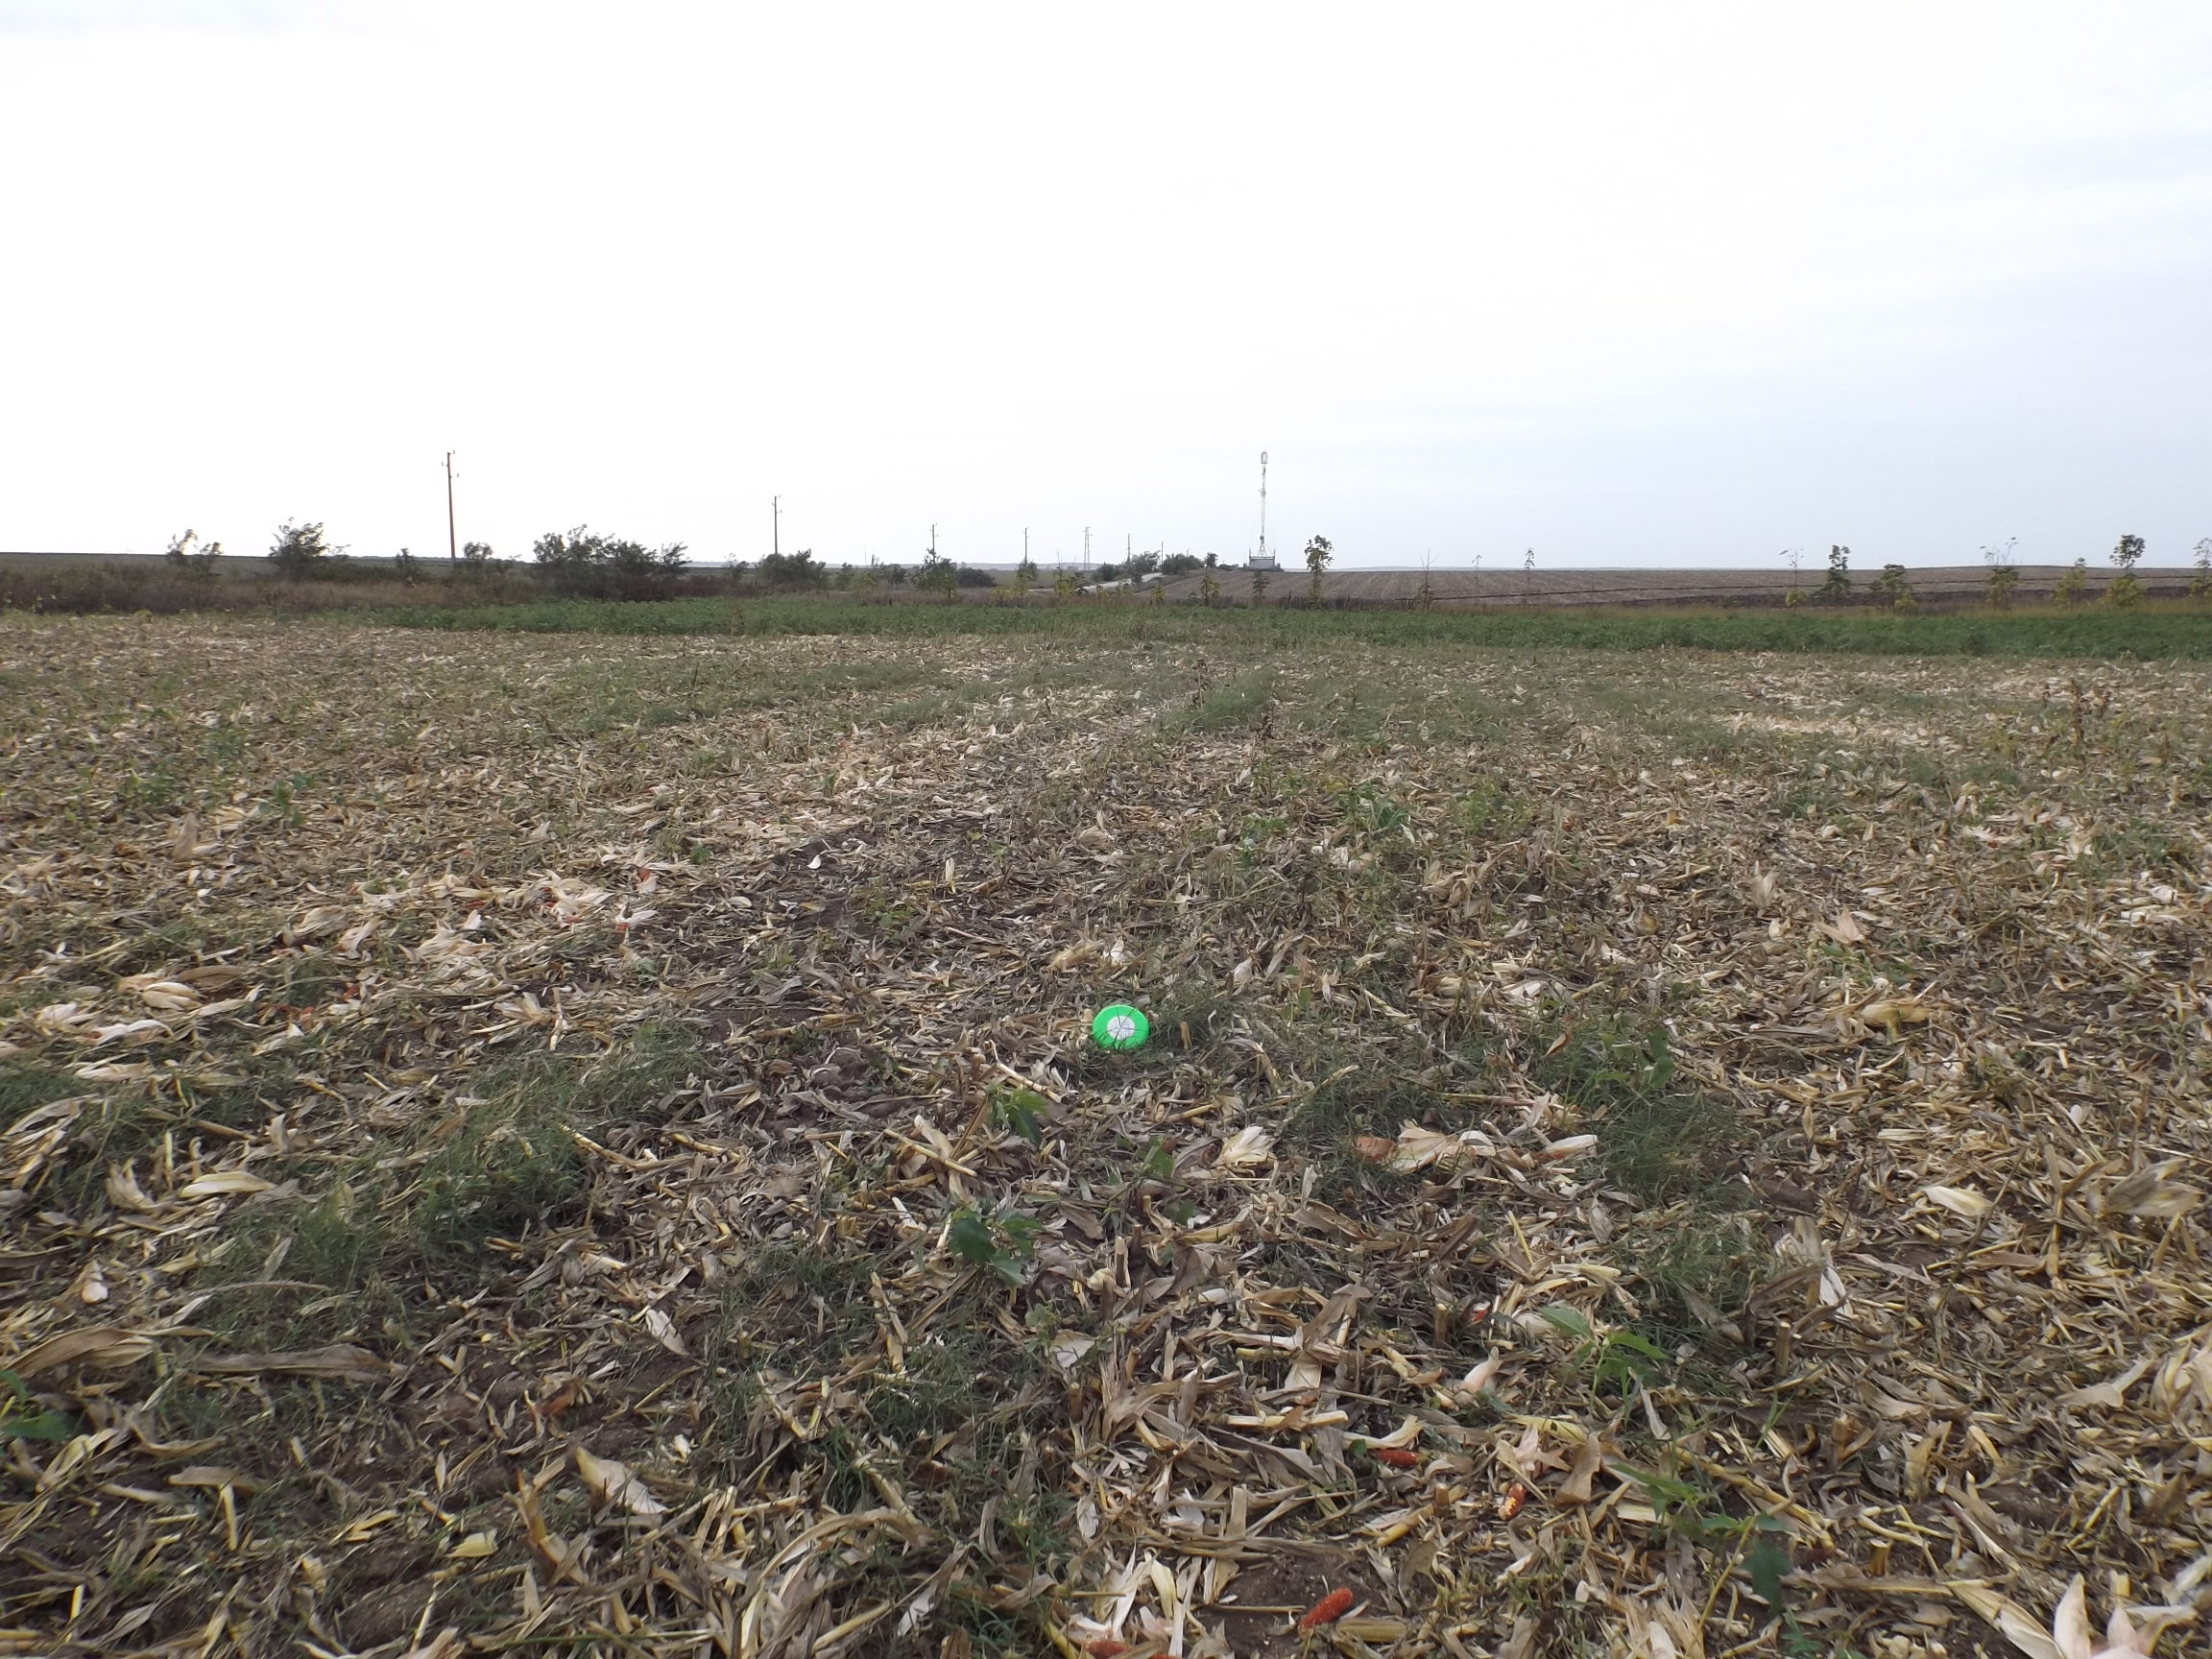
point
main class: Cropland
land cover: Maize
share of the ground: < 10 %
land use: Agriculture (excluding fallow land and kitchen gardens)
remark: Harvested field
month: October
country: BG
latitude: 43.9357
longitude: 26.8488
